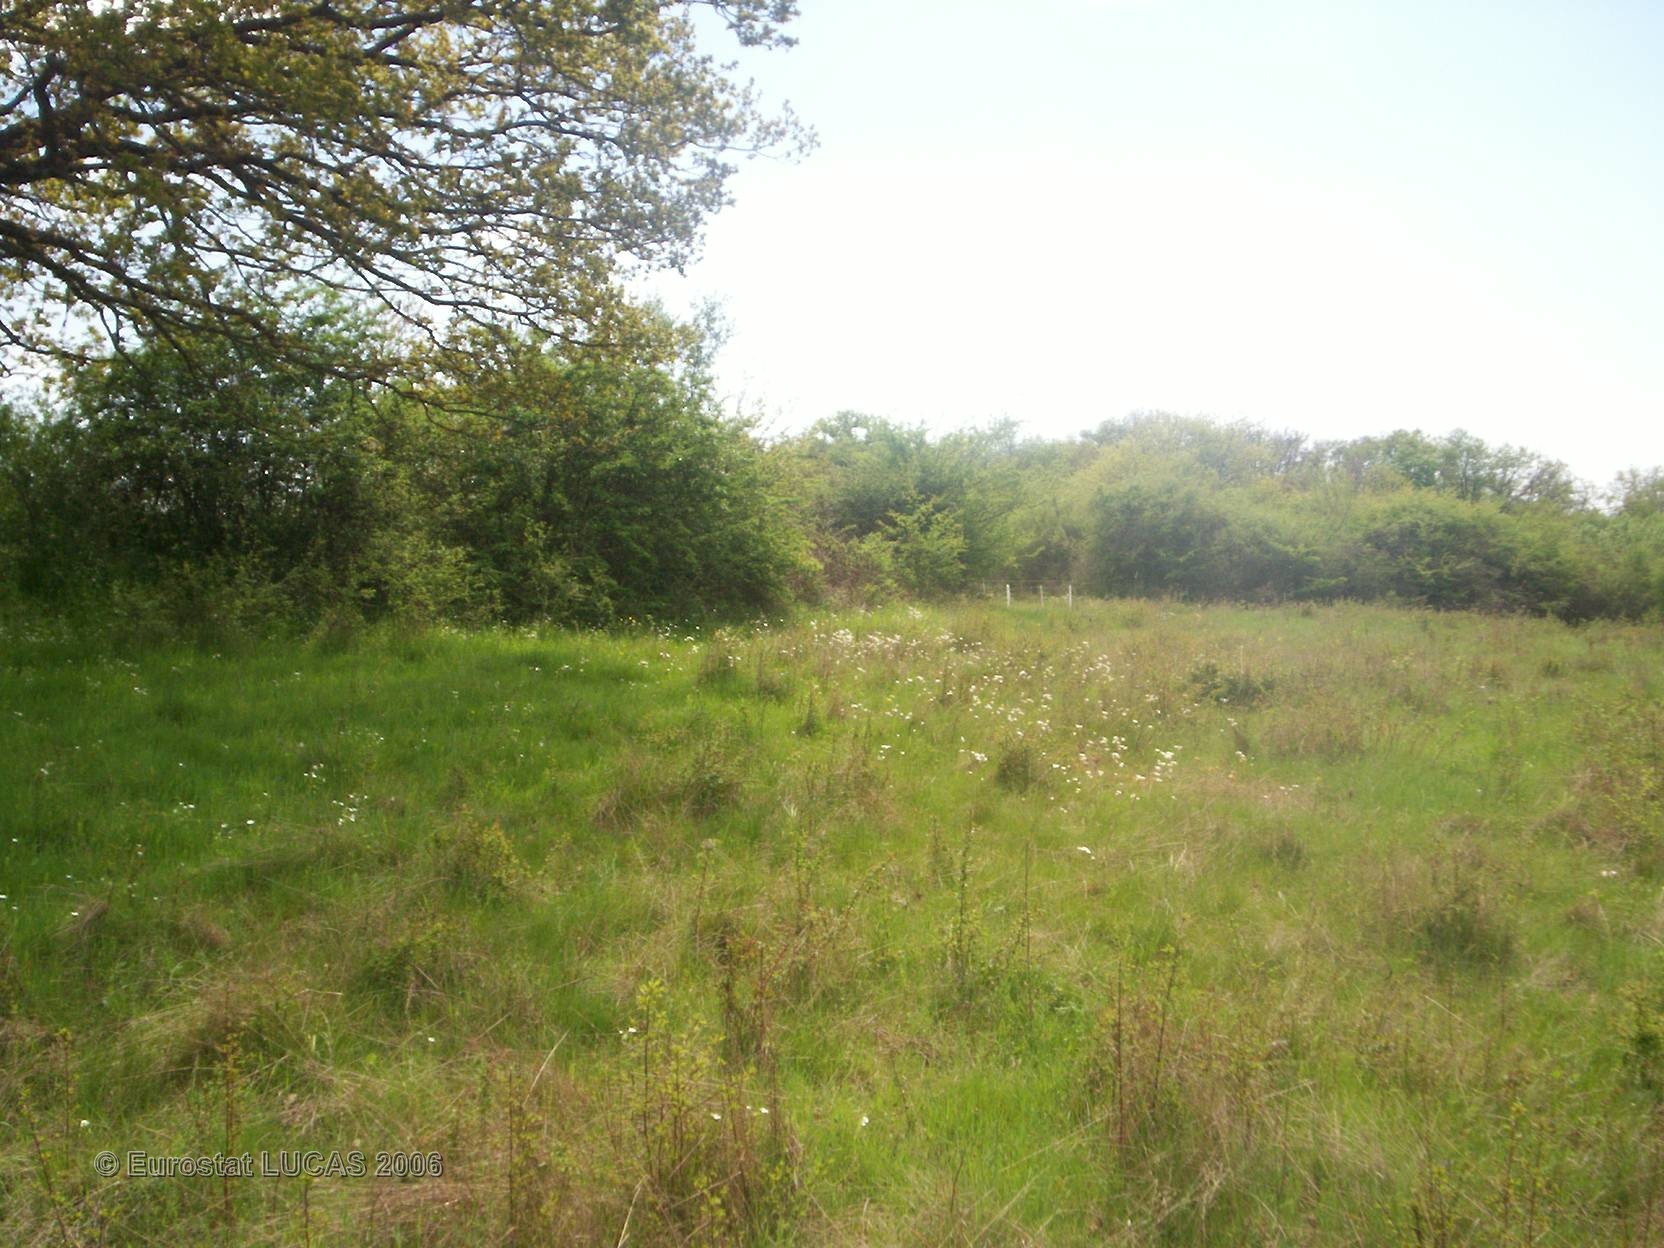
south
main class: Grassland
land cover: Grassland with sparse tree/shrub cover
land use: Unused
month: May
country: FR
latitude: 46.2734
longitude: 3.1077
